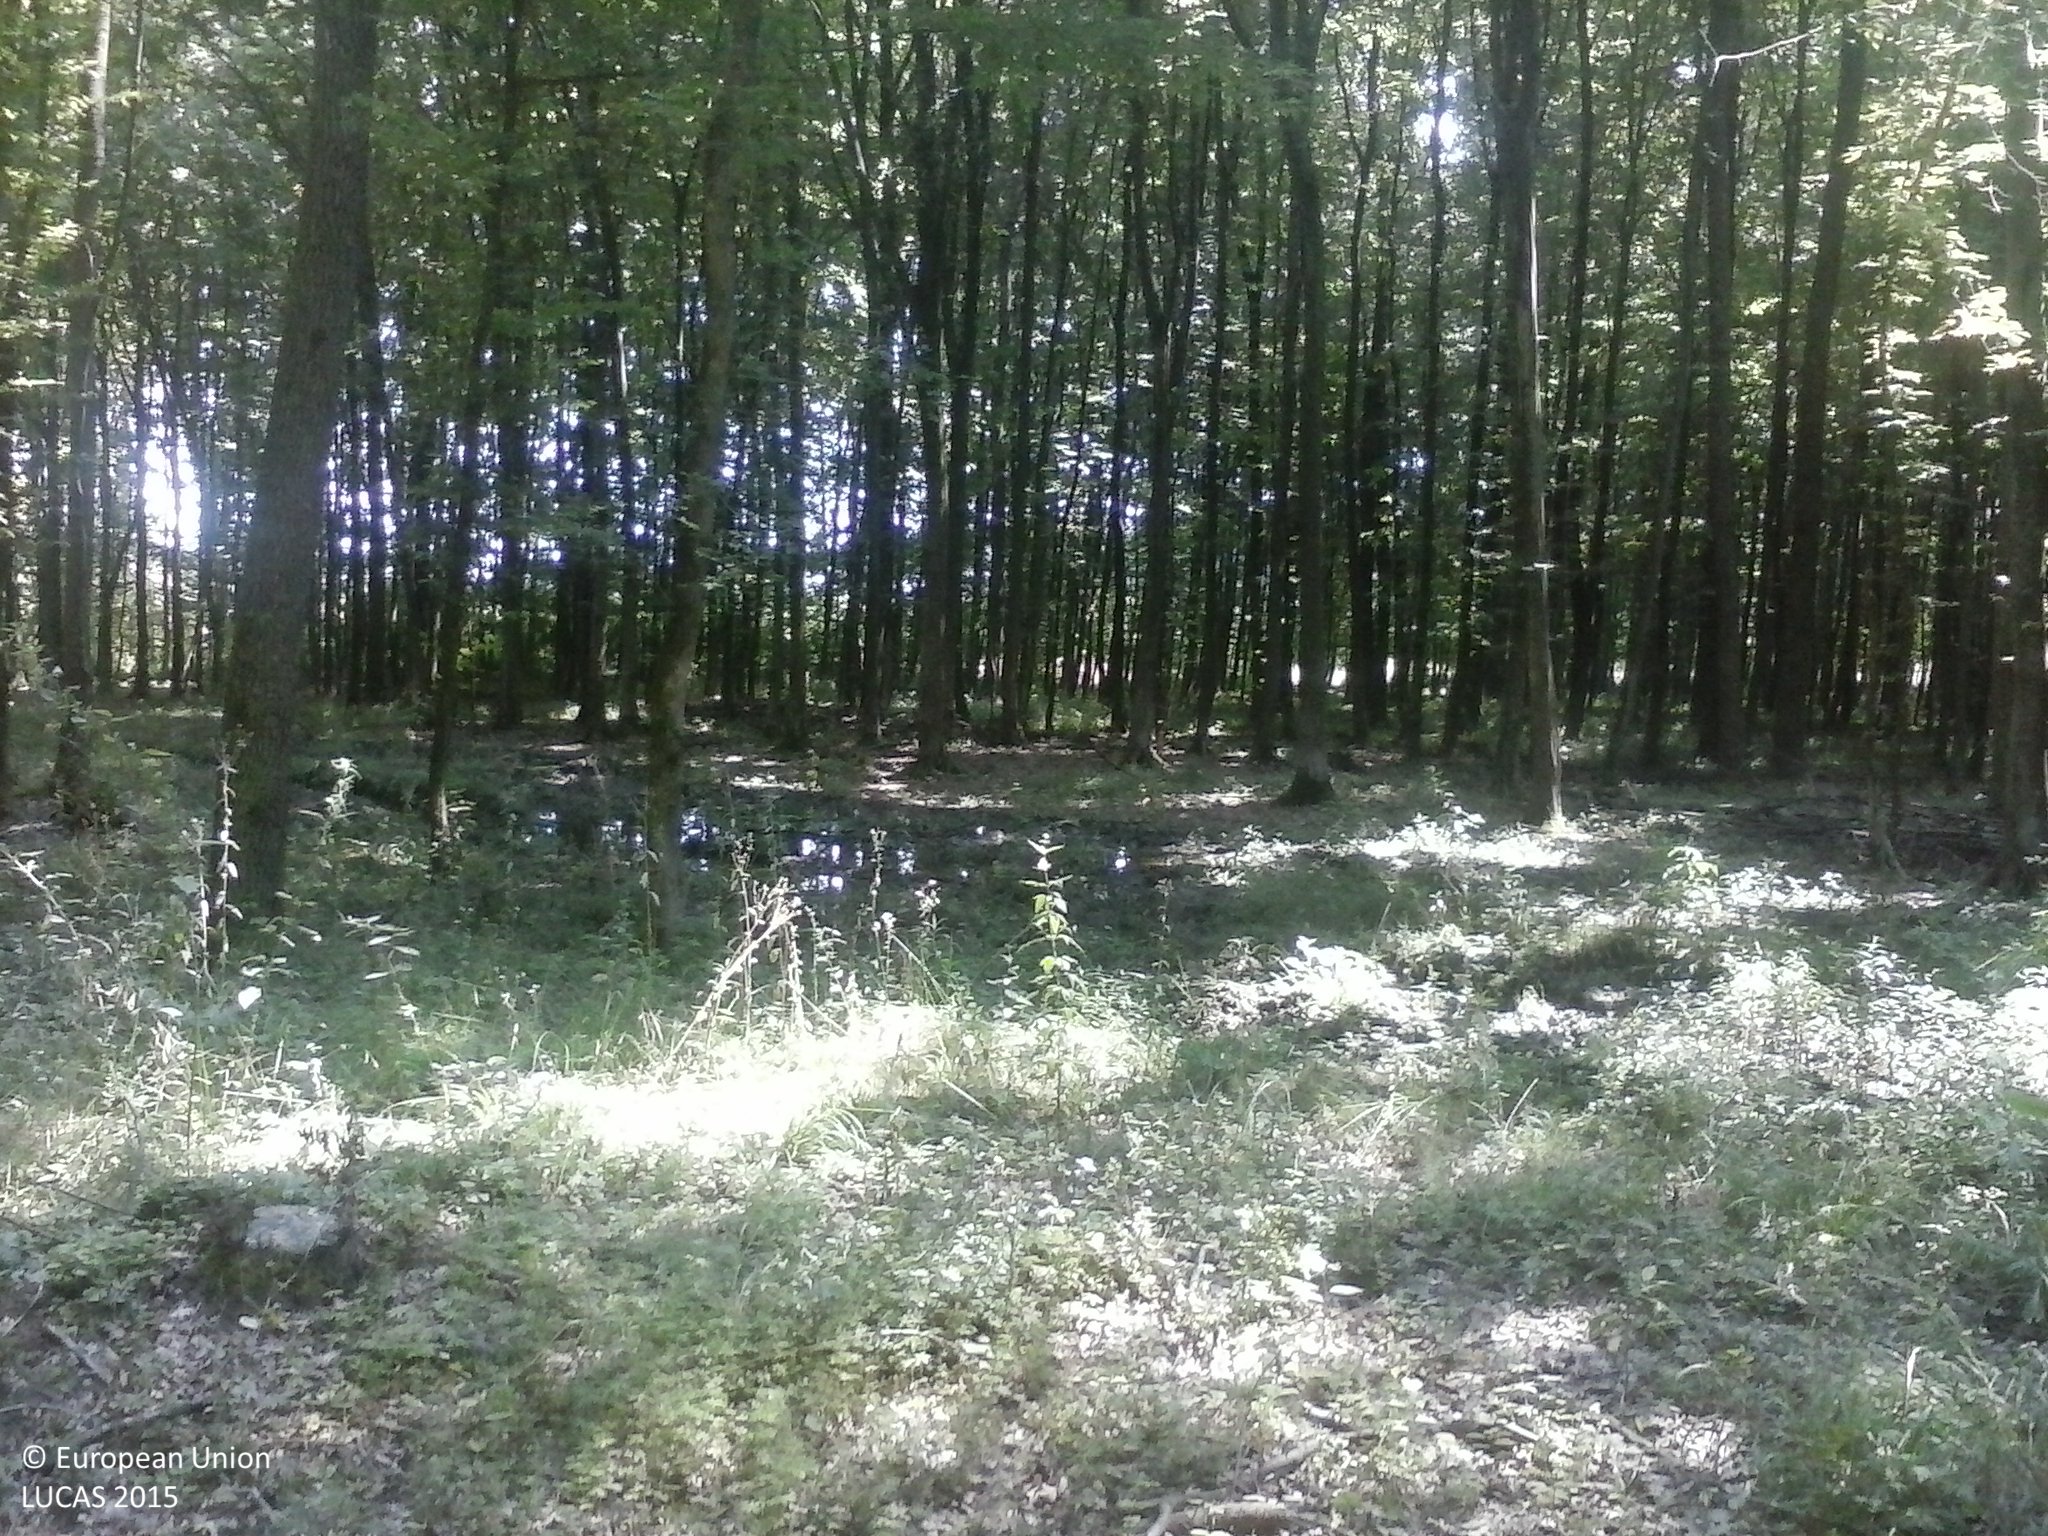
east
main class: Woodland
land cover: Broadleaved woodland
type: mesophytic deciduous forest
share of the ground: > 75 %
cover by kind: broadleaved forest trees 90 %, shrubs 5 %, consolidated bare surface 5 %
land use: Forestry
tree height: > 5 m
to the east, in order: Broadleaved woodland; Grass margins; Tracks; Grass margins; Broadleaved woodland
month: August
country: HU
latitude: 45.8747
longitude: 17.6951
